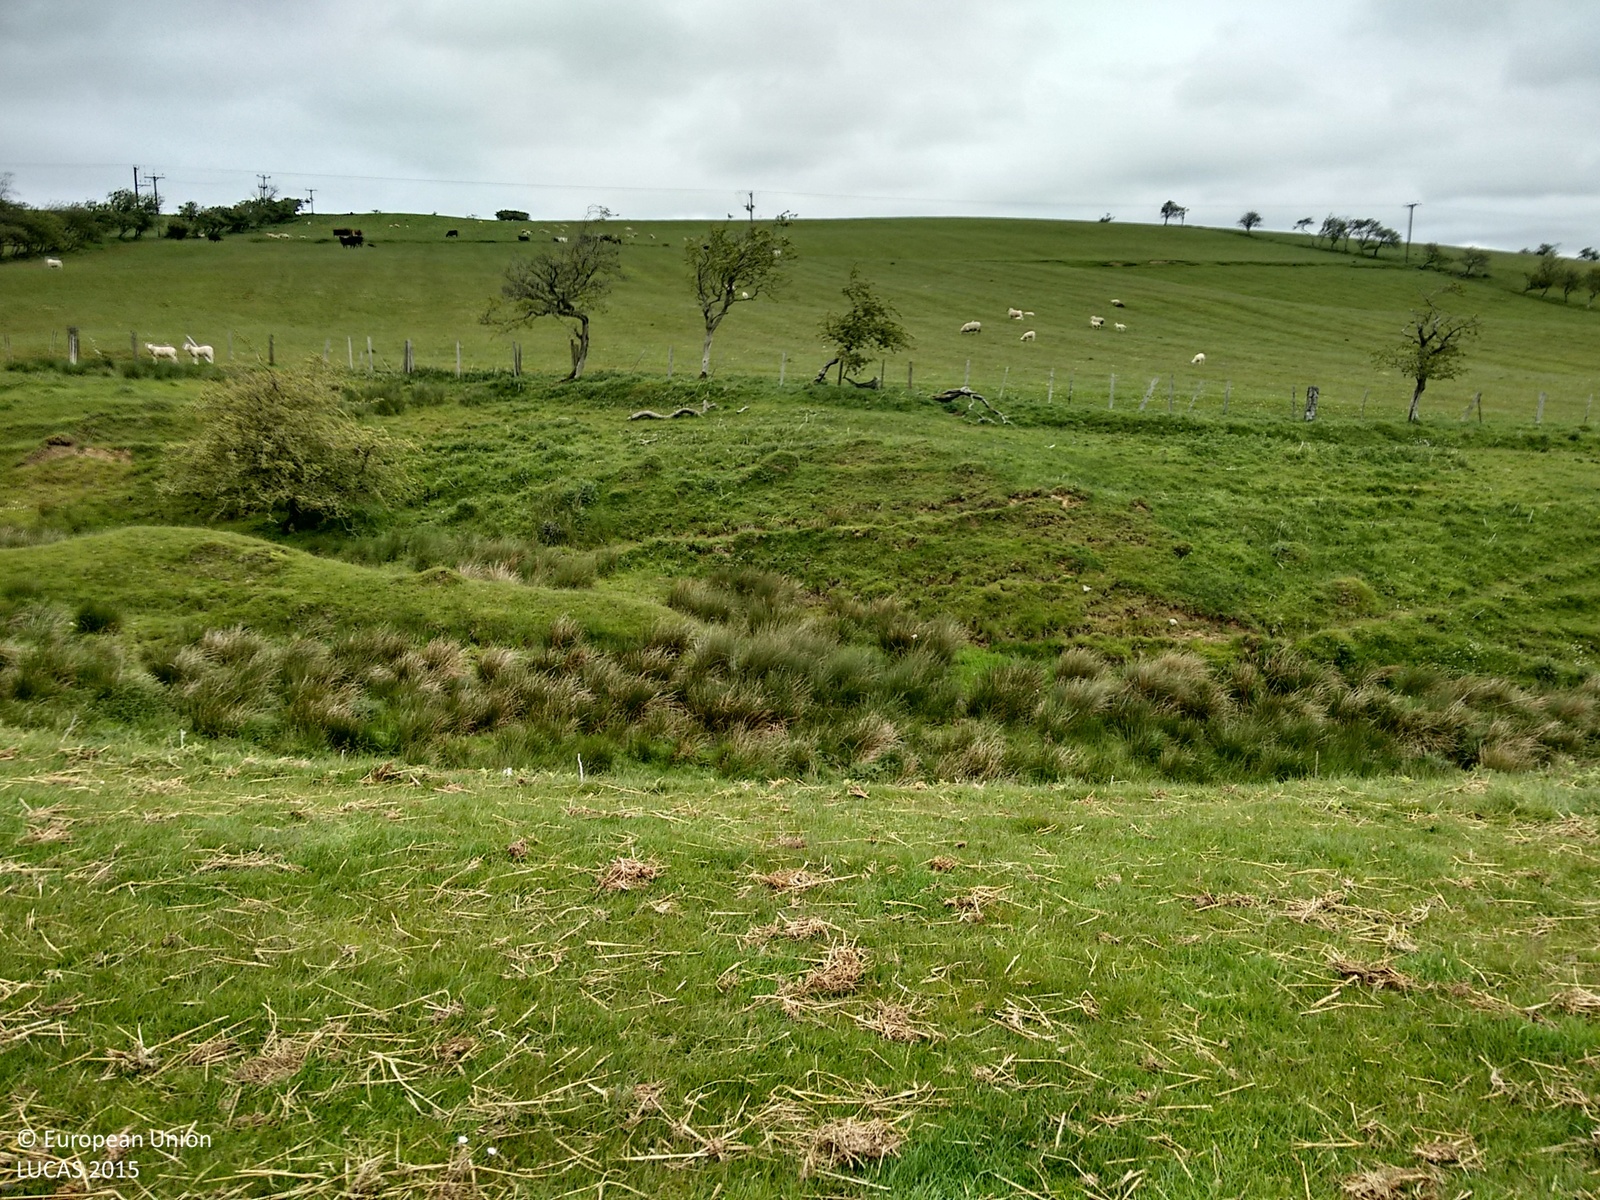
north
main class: Grassland
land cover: Grassland without tree/shrub cover
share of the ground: > 75 %
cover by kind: herbaceous plants 100 %
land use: Agriculture (excluding fallow land and kitchen gardens)
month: June
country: GB
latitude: 55.0871
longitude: -2.2630
